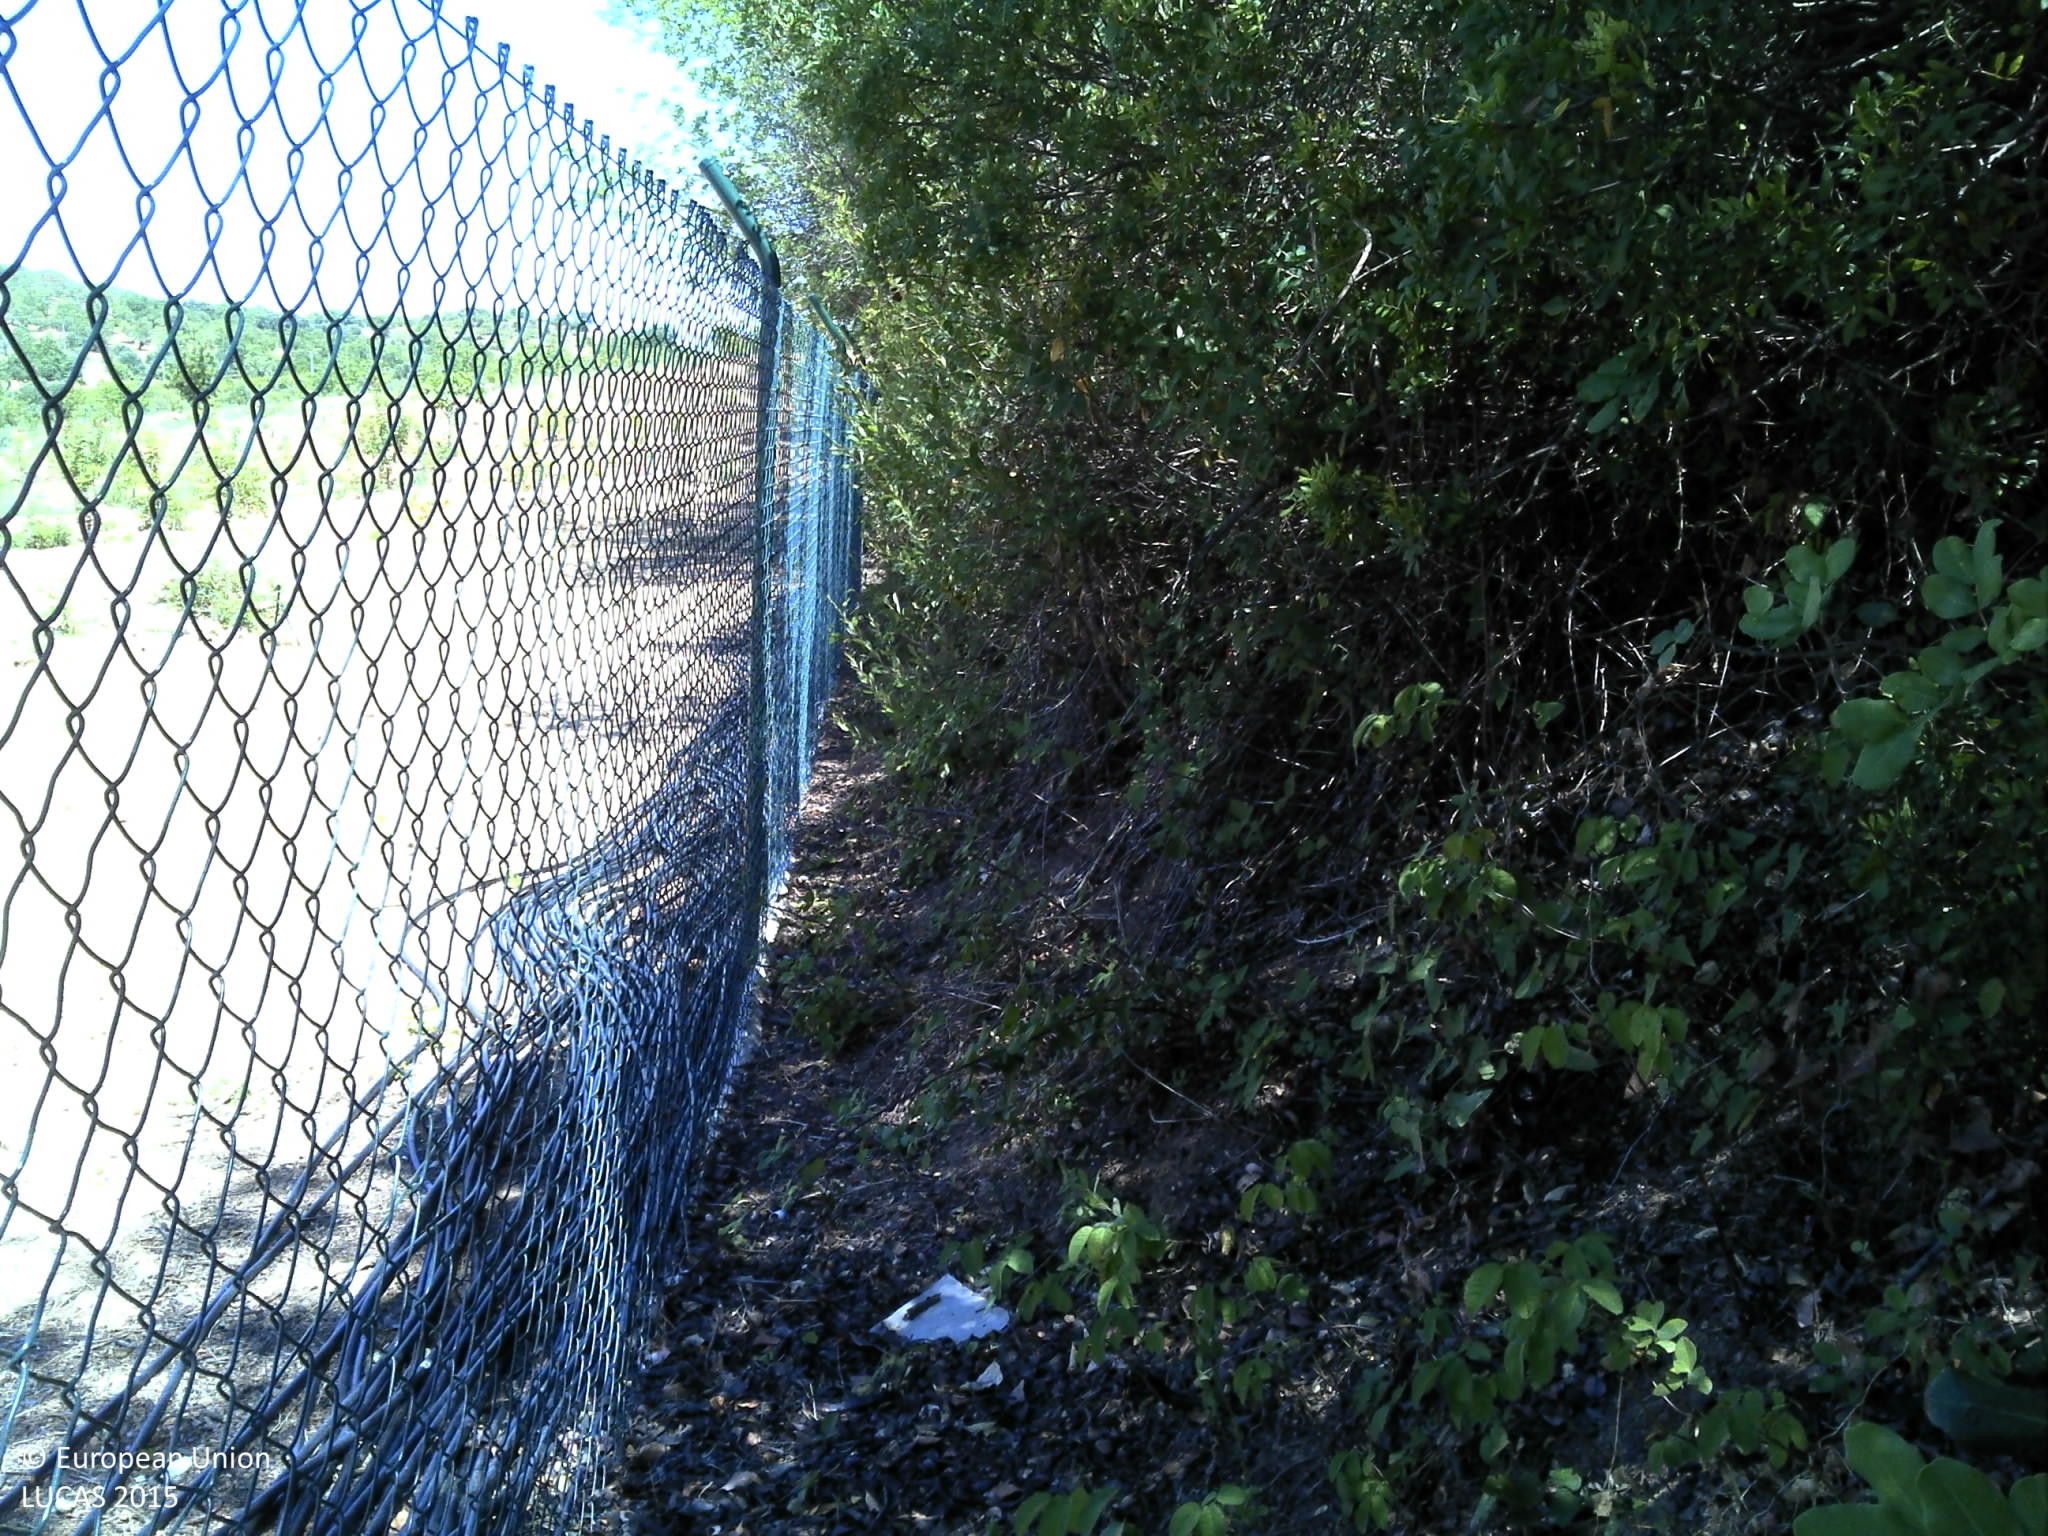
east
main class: Cropland
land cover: Permanent industrial crops
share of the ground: < 10 %
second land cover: Spontaneously vegetated surfaces
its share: 10 - 25 %
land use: Agriculture (excluding fallow land and kitchen gardens)
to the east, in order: Permanent industrial crops; Spontaneously vegetated surfaces; Grassland with sparse tree/shrub cover; Fences; Tracks; Shruby margins; Oranges
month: June
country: PT
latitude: 37.1524
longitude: -7.7641
